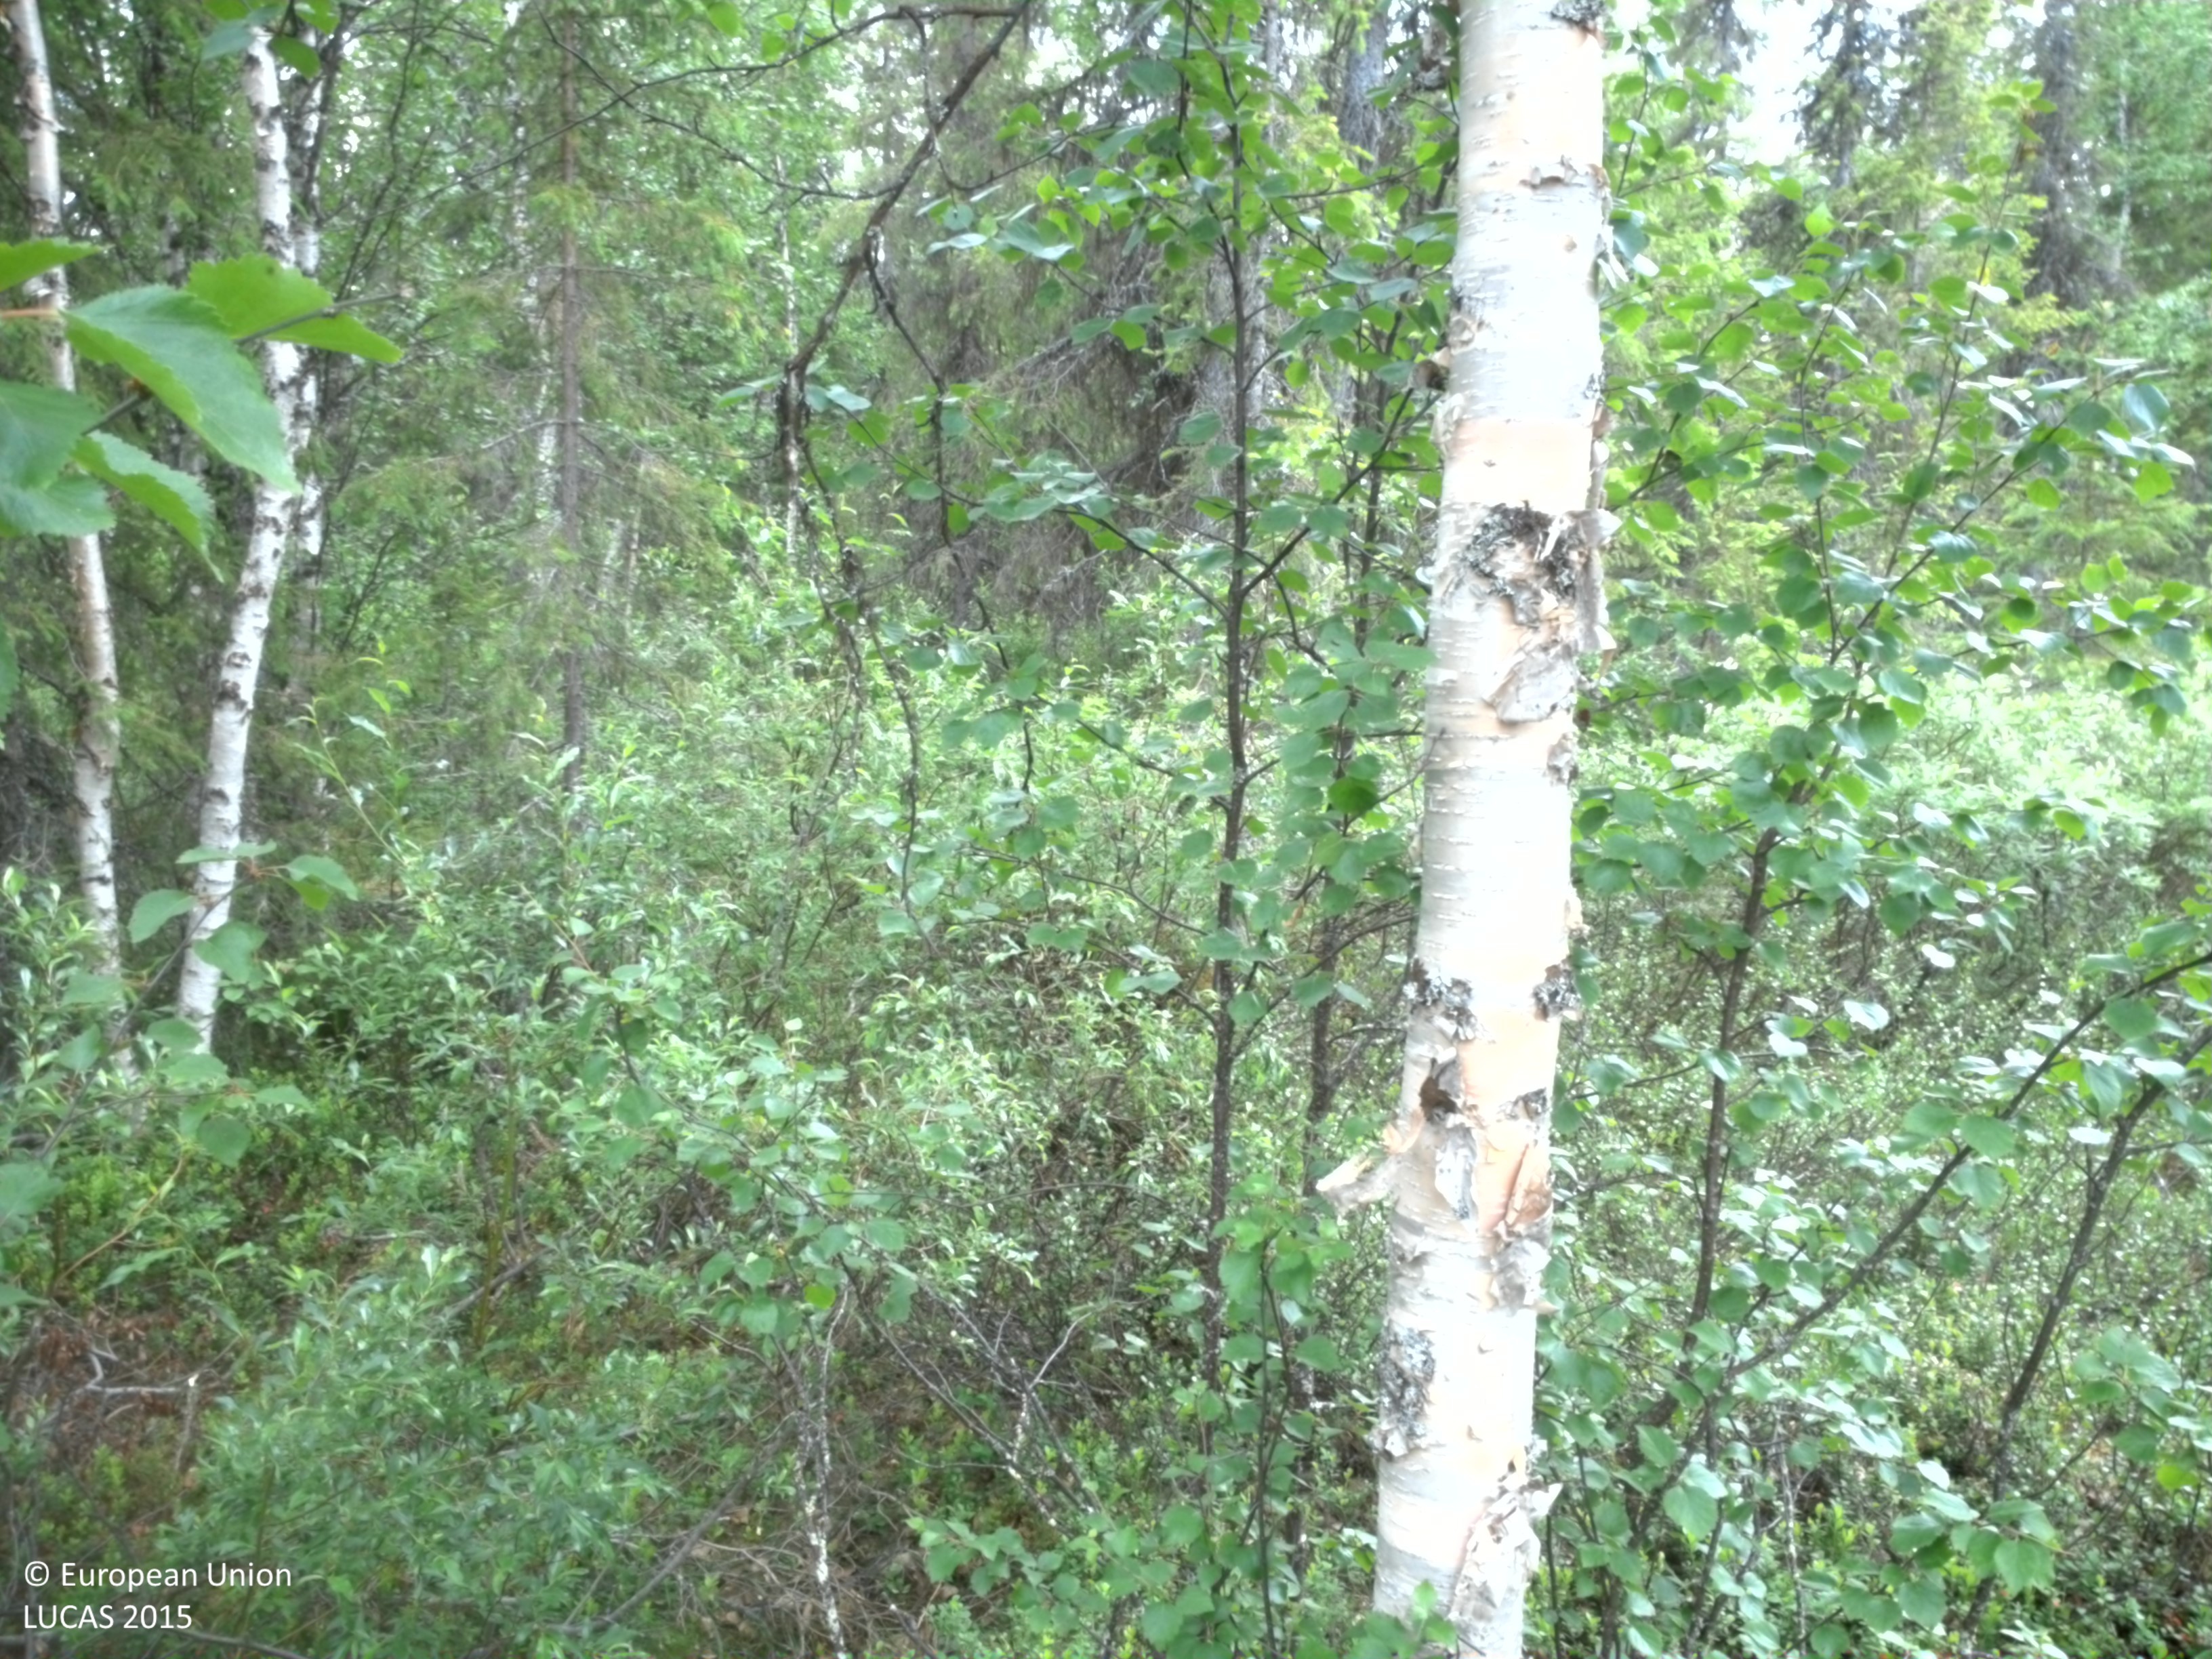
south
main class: Woodland
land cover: Pine dominated mixed woodland
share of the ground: 10 - 25 %
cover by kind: shrubs 75 %, broadleaved forest trees 15 %, coniferous forest trees 10 %
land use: Forestry
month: July
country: SE
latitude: 66.9087
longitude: 18.3328
